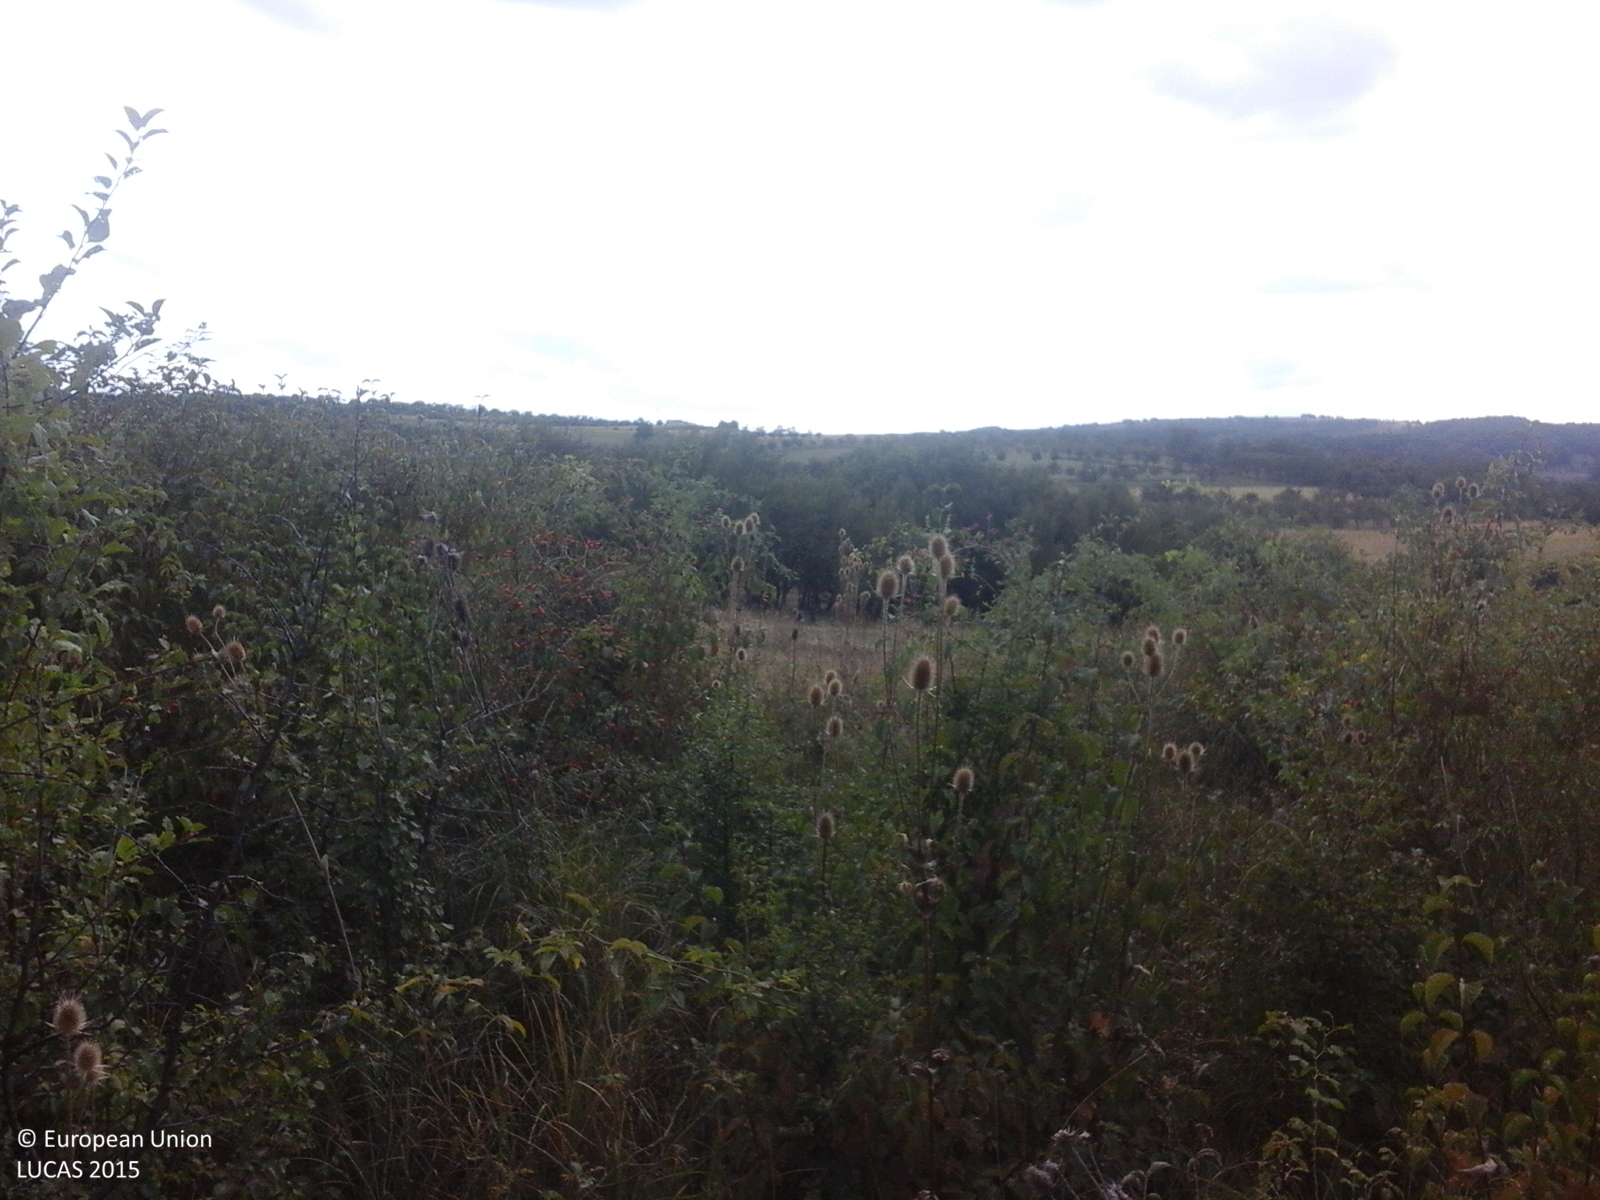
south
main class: Shrubland
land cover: Shrubland without tree cover
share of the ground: > 75 %
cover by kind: shrubs 100 %
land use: Fallow land
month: September
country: RO
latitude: 47.4665
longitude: 23.4591
